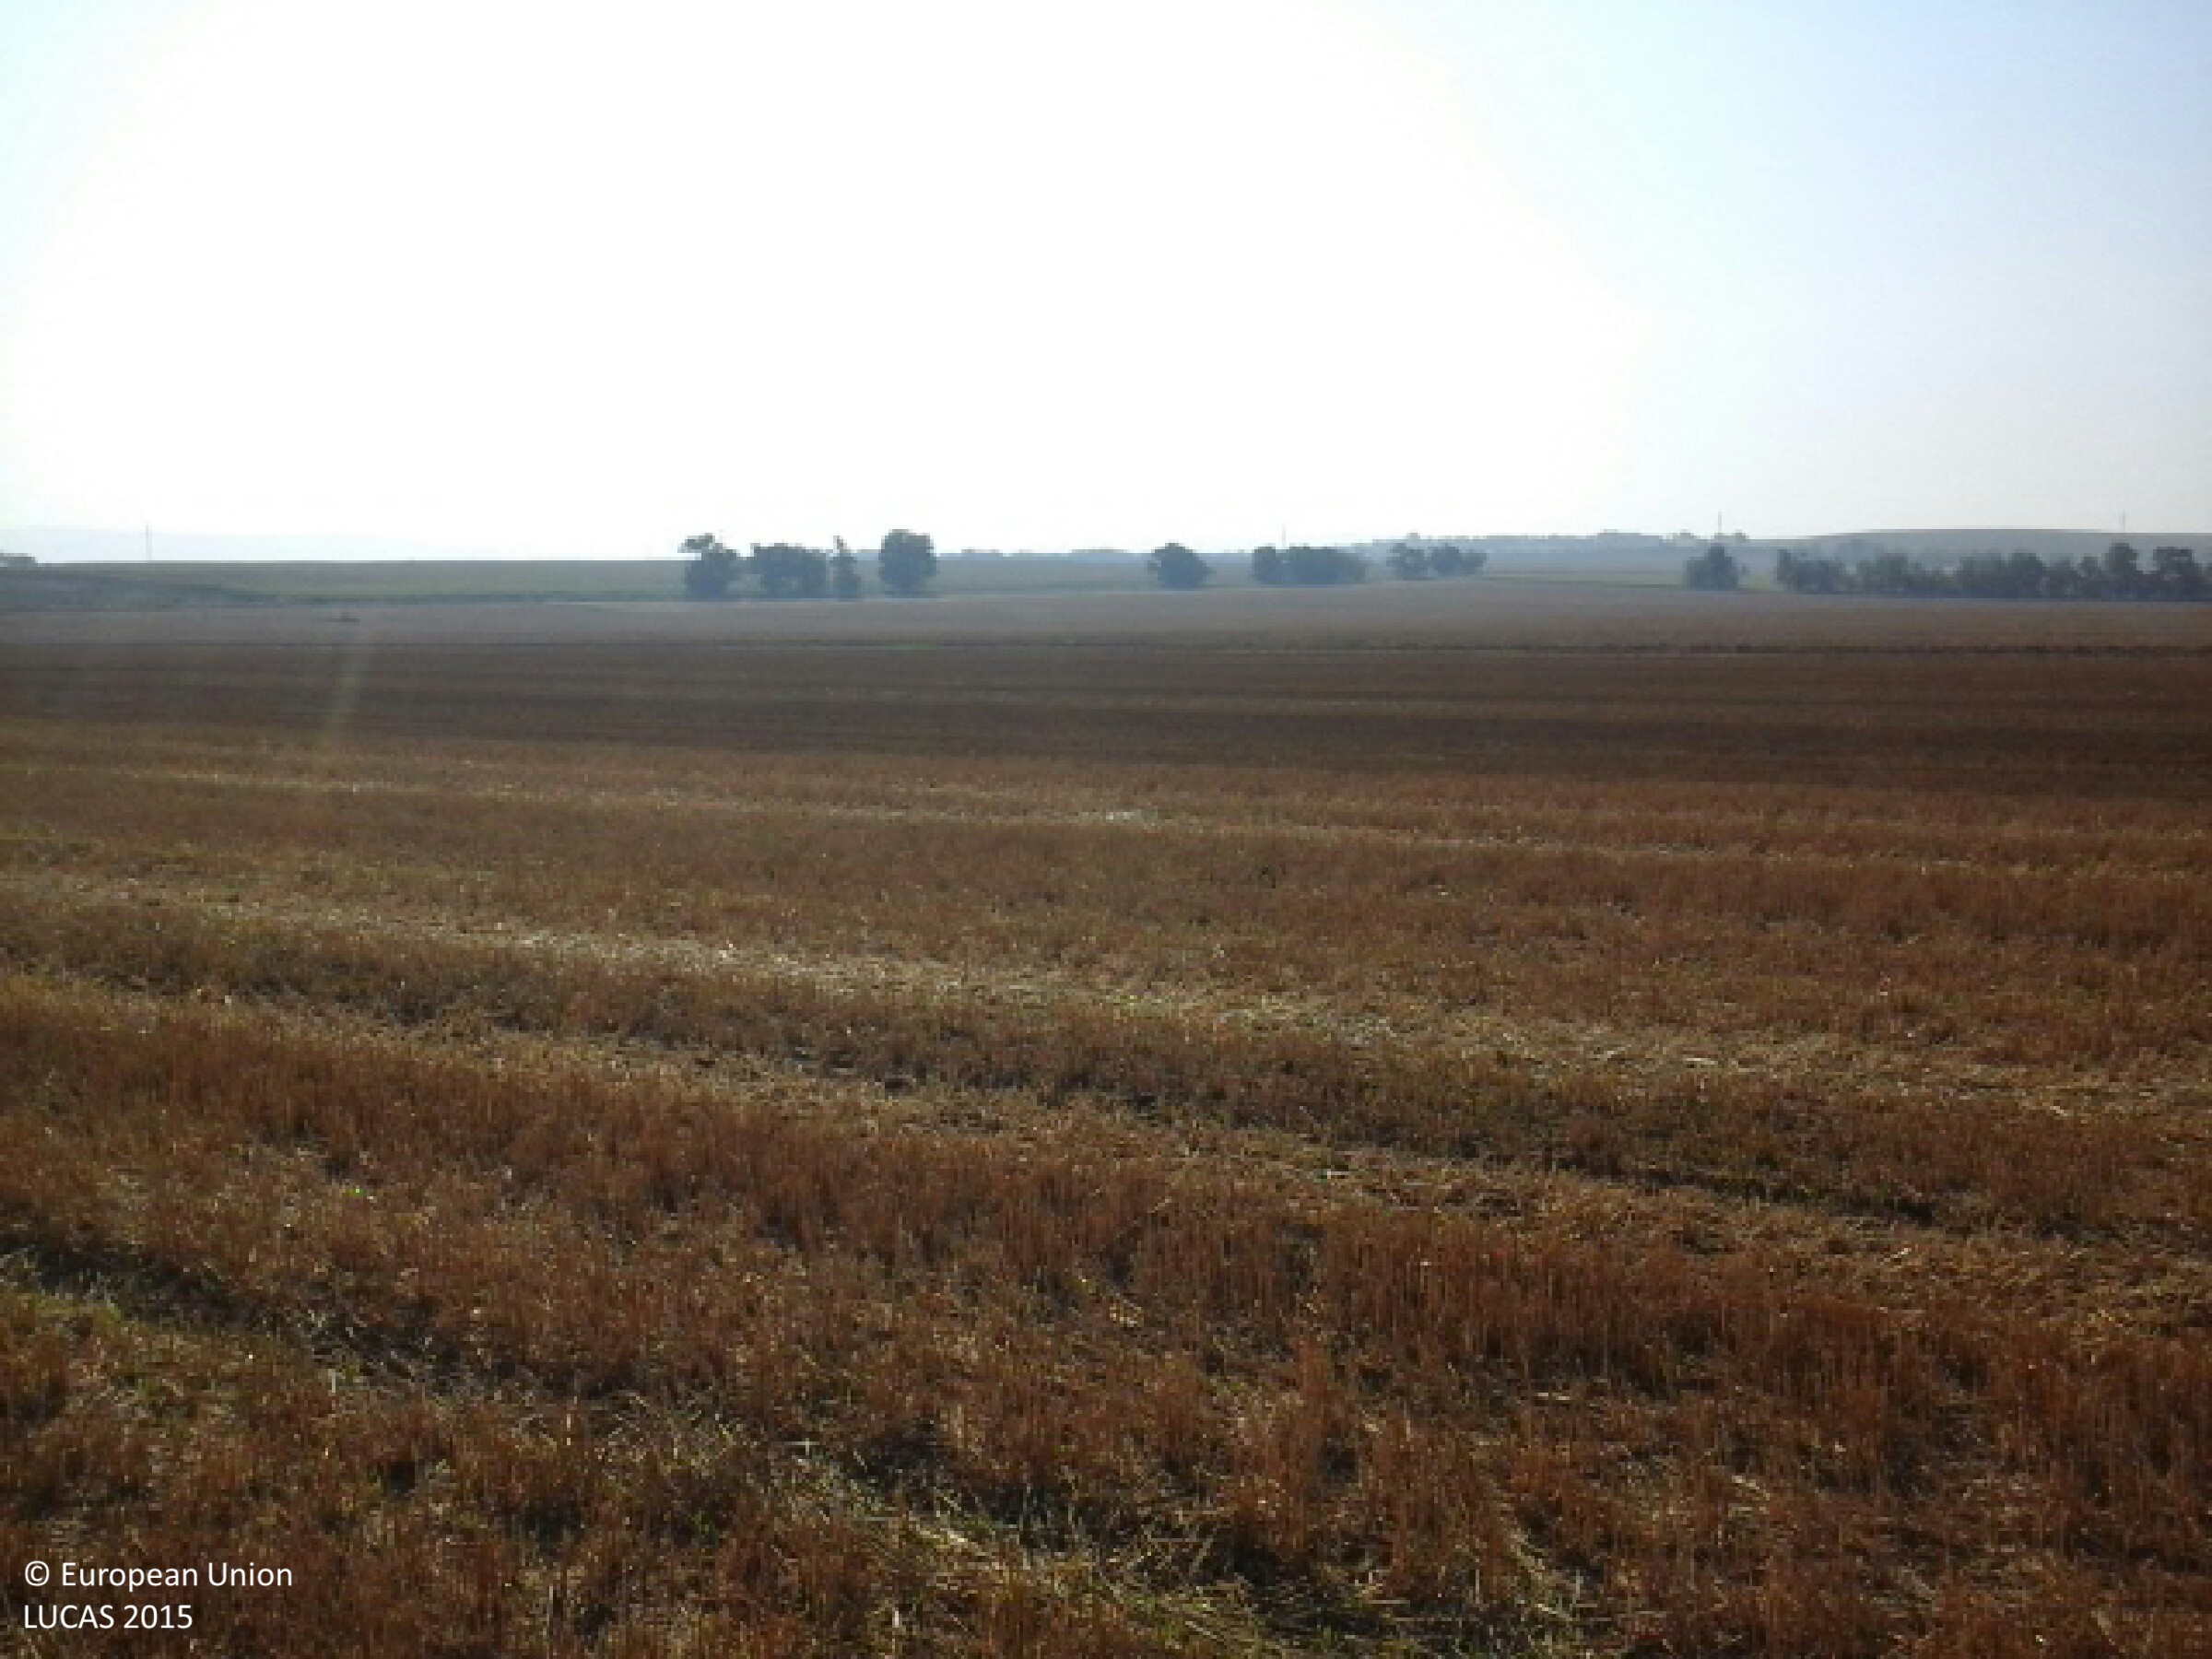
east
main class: Cropland
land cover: Common wheat
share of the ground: 10 - 25 %
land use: Agriculture (excluding fallow land and kitchen gardens)
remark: Harvested field
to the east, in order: Common wheat; Triticale
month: August
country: HU
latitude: 47.6782
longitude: 18.2581
